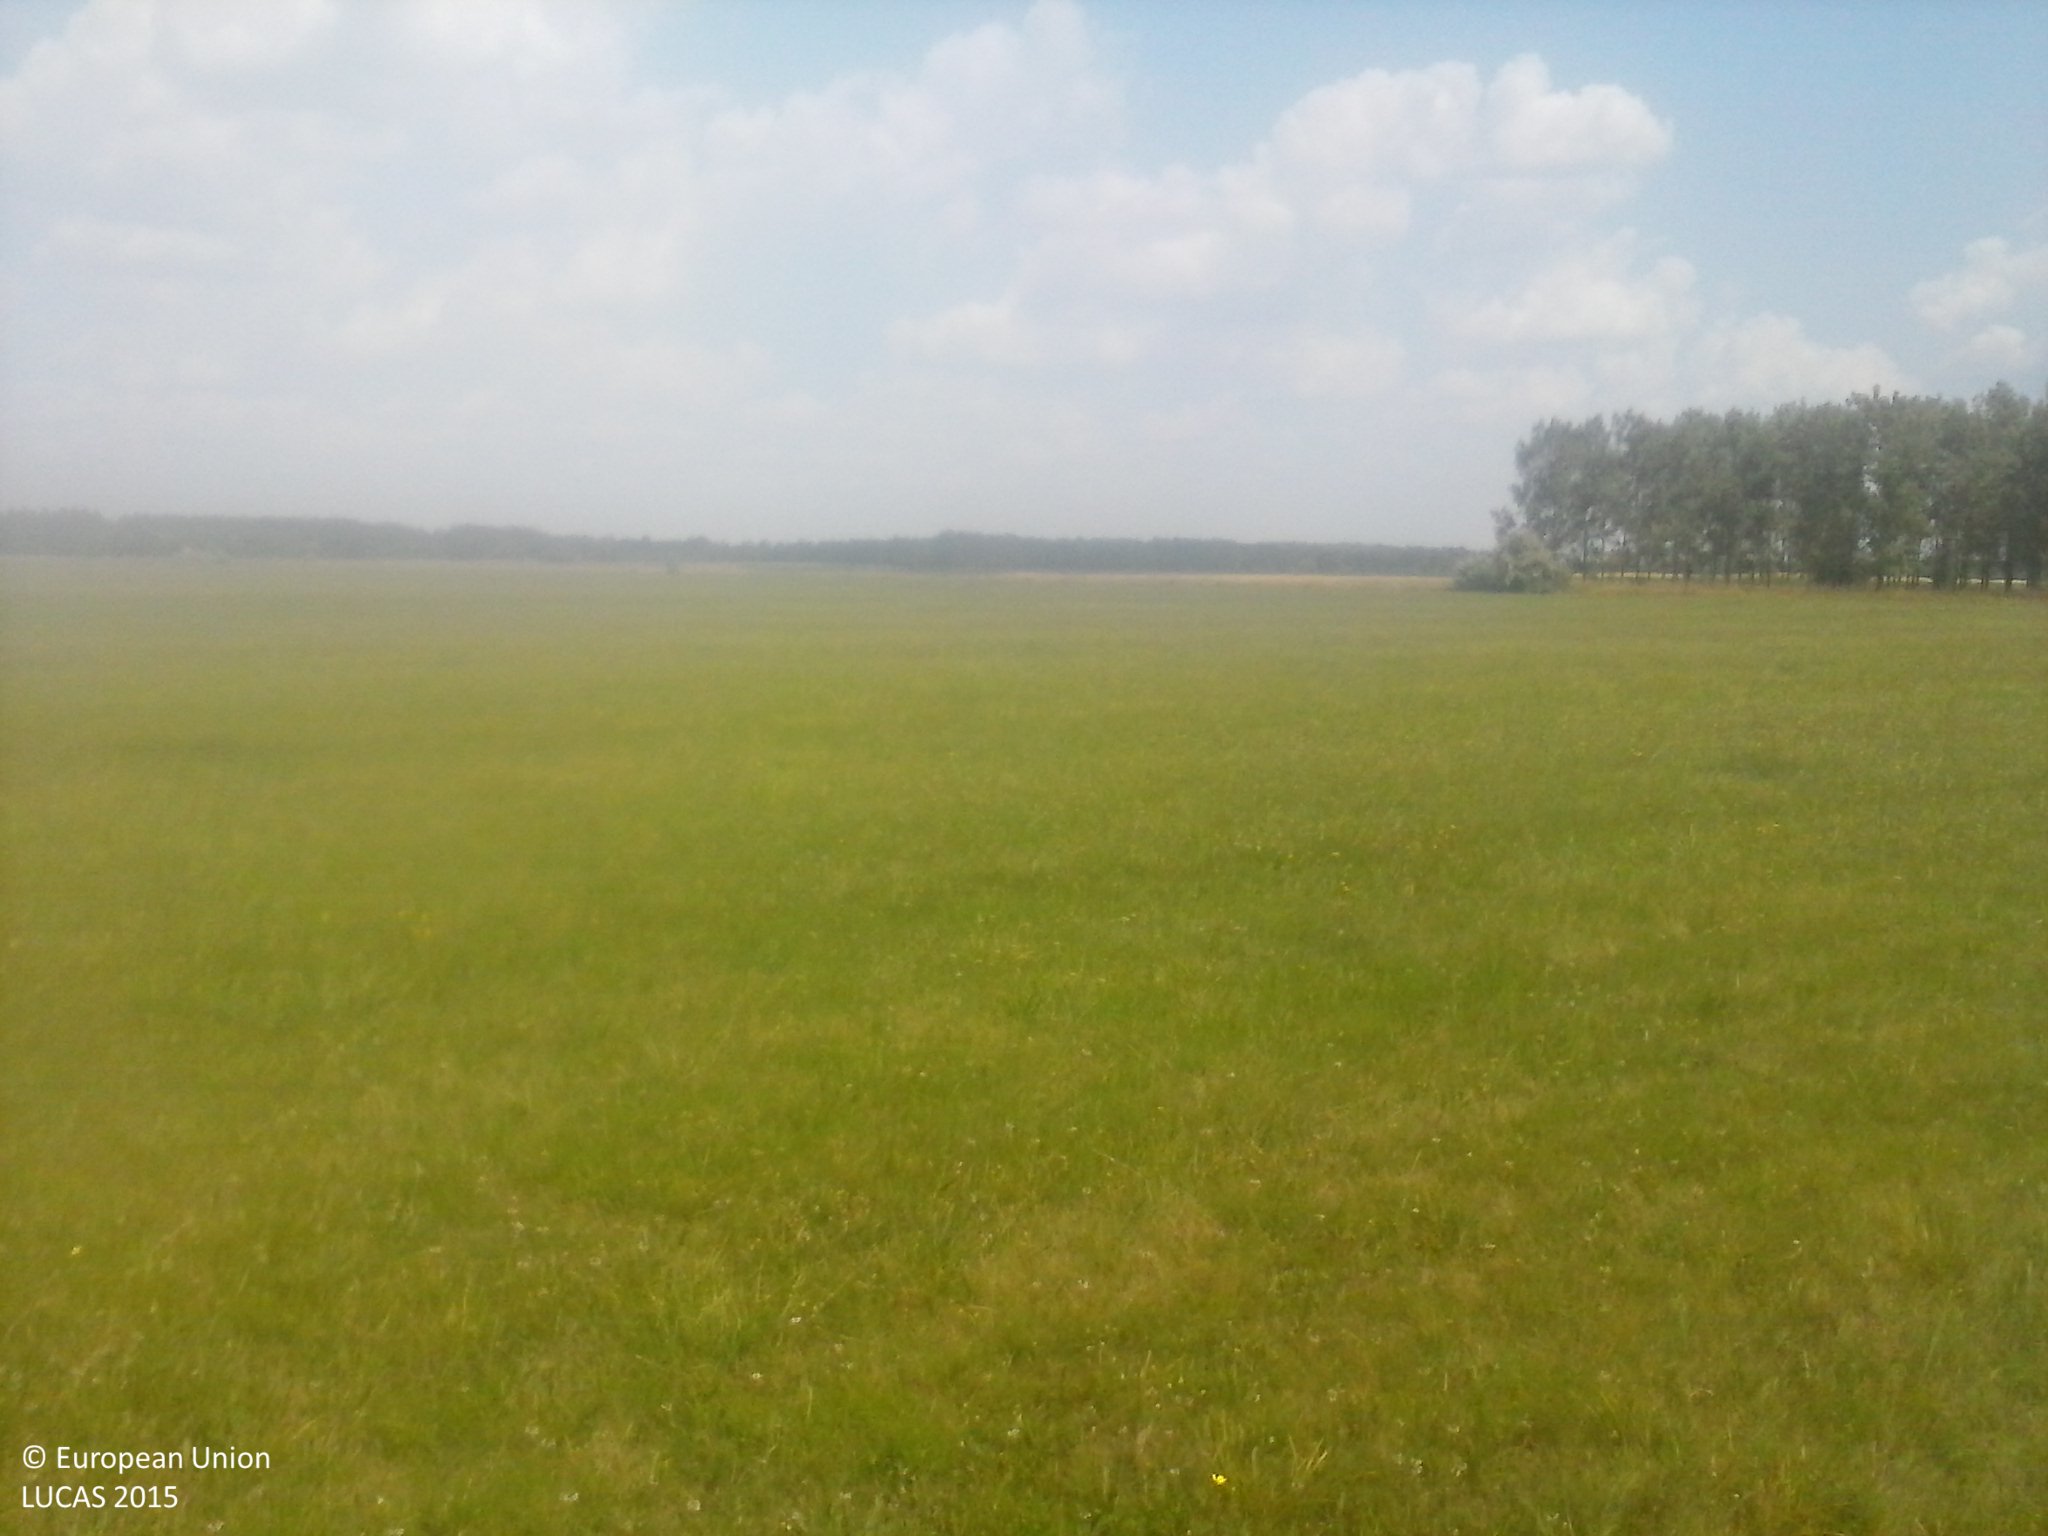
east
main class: Grassland
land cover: Grassland without tree/shrub cover
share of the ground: > 75 %
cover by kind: herbaceous plants 100 %
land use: Agriculture (excluding fallow land and kitchen gardens)
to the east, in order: Grassland without tree/shrub cover; Inland fresh running water; Grass margins; Tracks; Grass margins; Maize
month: July
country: HU
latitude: 46.3633
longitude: 19.4921
